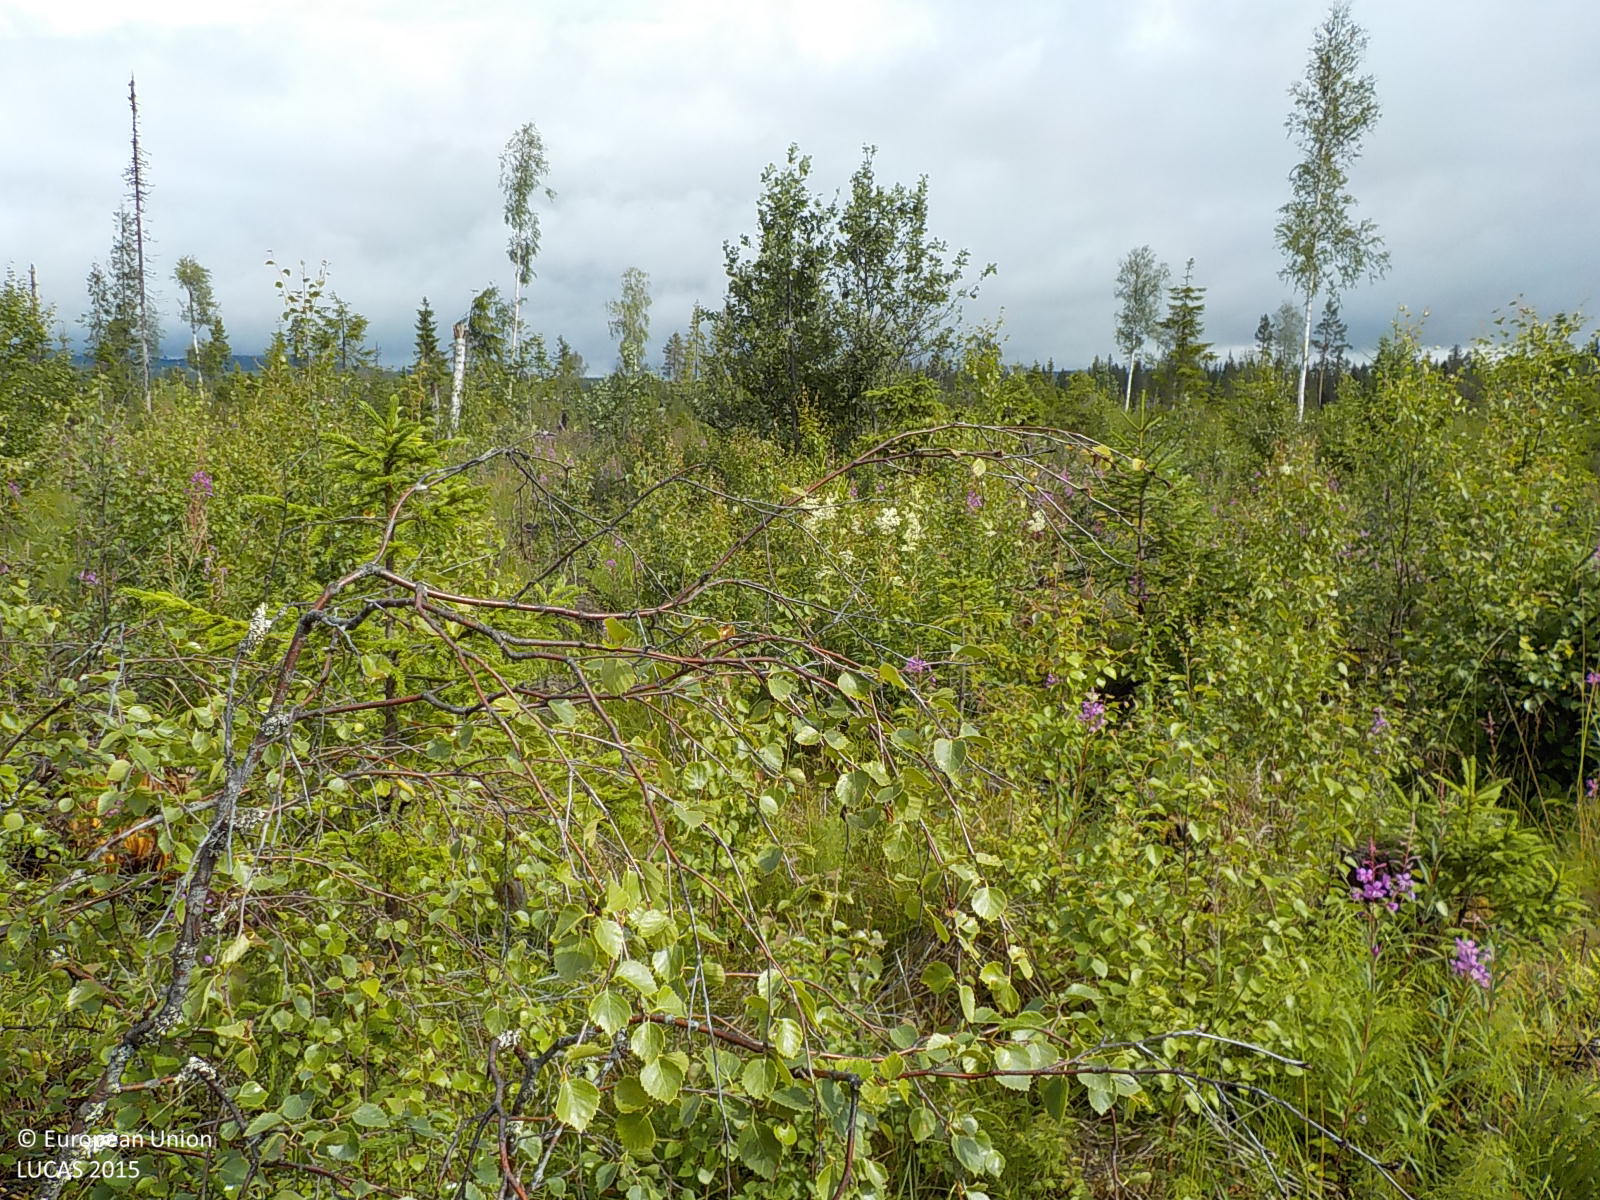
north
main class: Woodland
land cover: Broadleaved woodland
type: boreal forest
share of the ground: 50 - 75 %
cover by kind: shrubs 50 %, broadleaved forest trees 40 %, coniferous forest trees 10 %
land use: Forestry
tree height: < 5 m
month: July
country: SE
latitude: 63.2141
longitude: 16.9168
